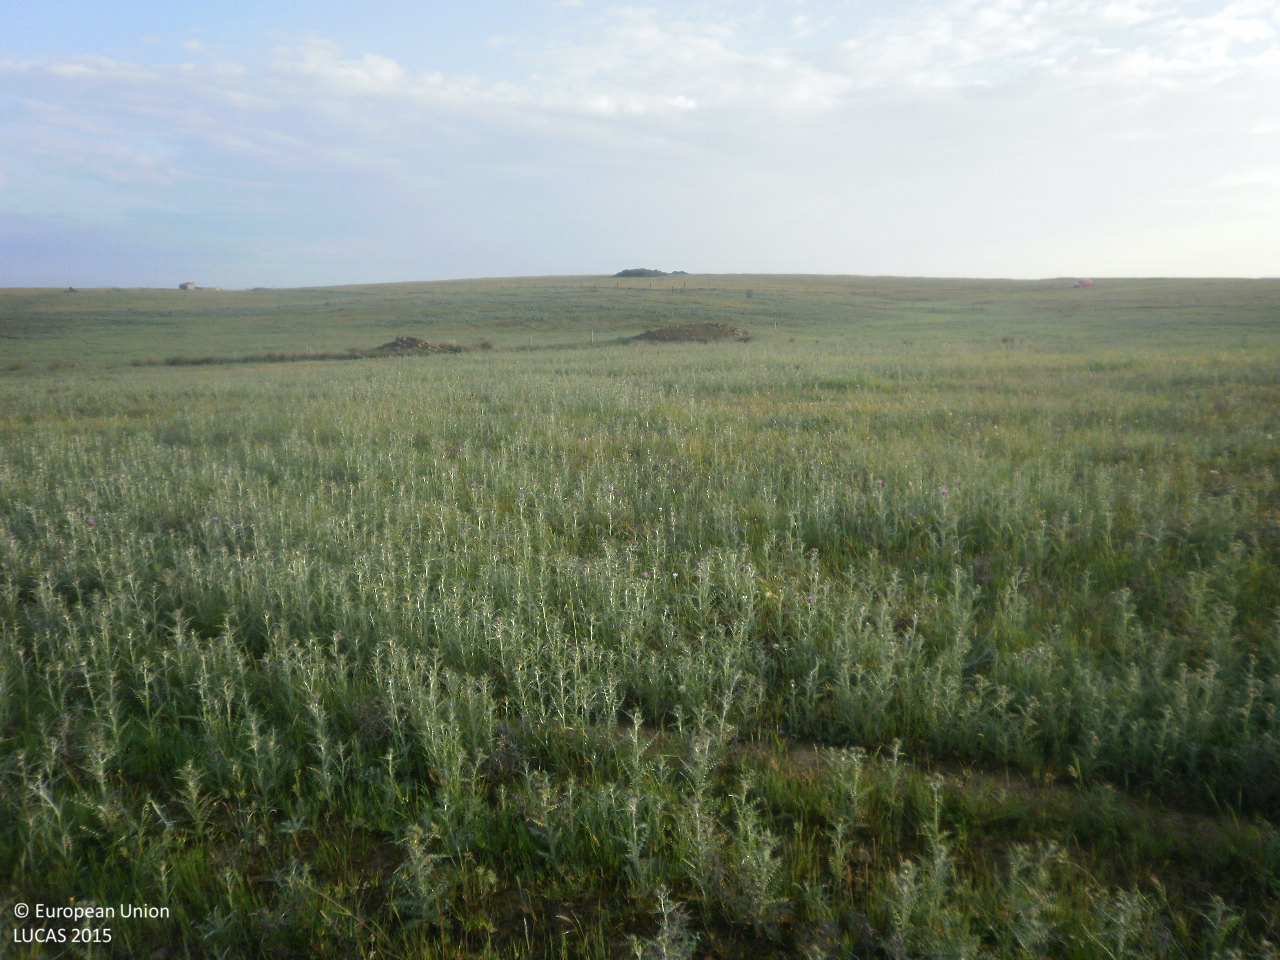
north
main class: Grassland
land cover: Grassland without tree/shrub cover
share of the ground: > 75 %
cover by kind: herbaceous plants 100 %
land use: Agriculture (excluding fallow land and kitchen gardens)
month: April
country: ES
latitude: 38.8209
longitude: -5.1814
